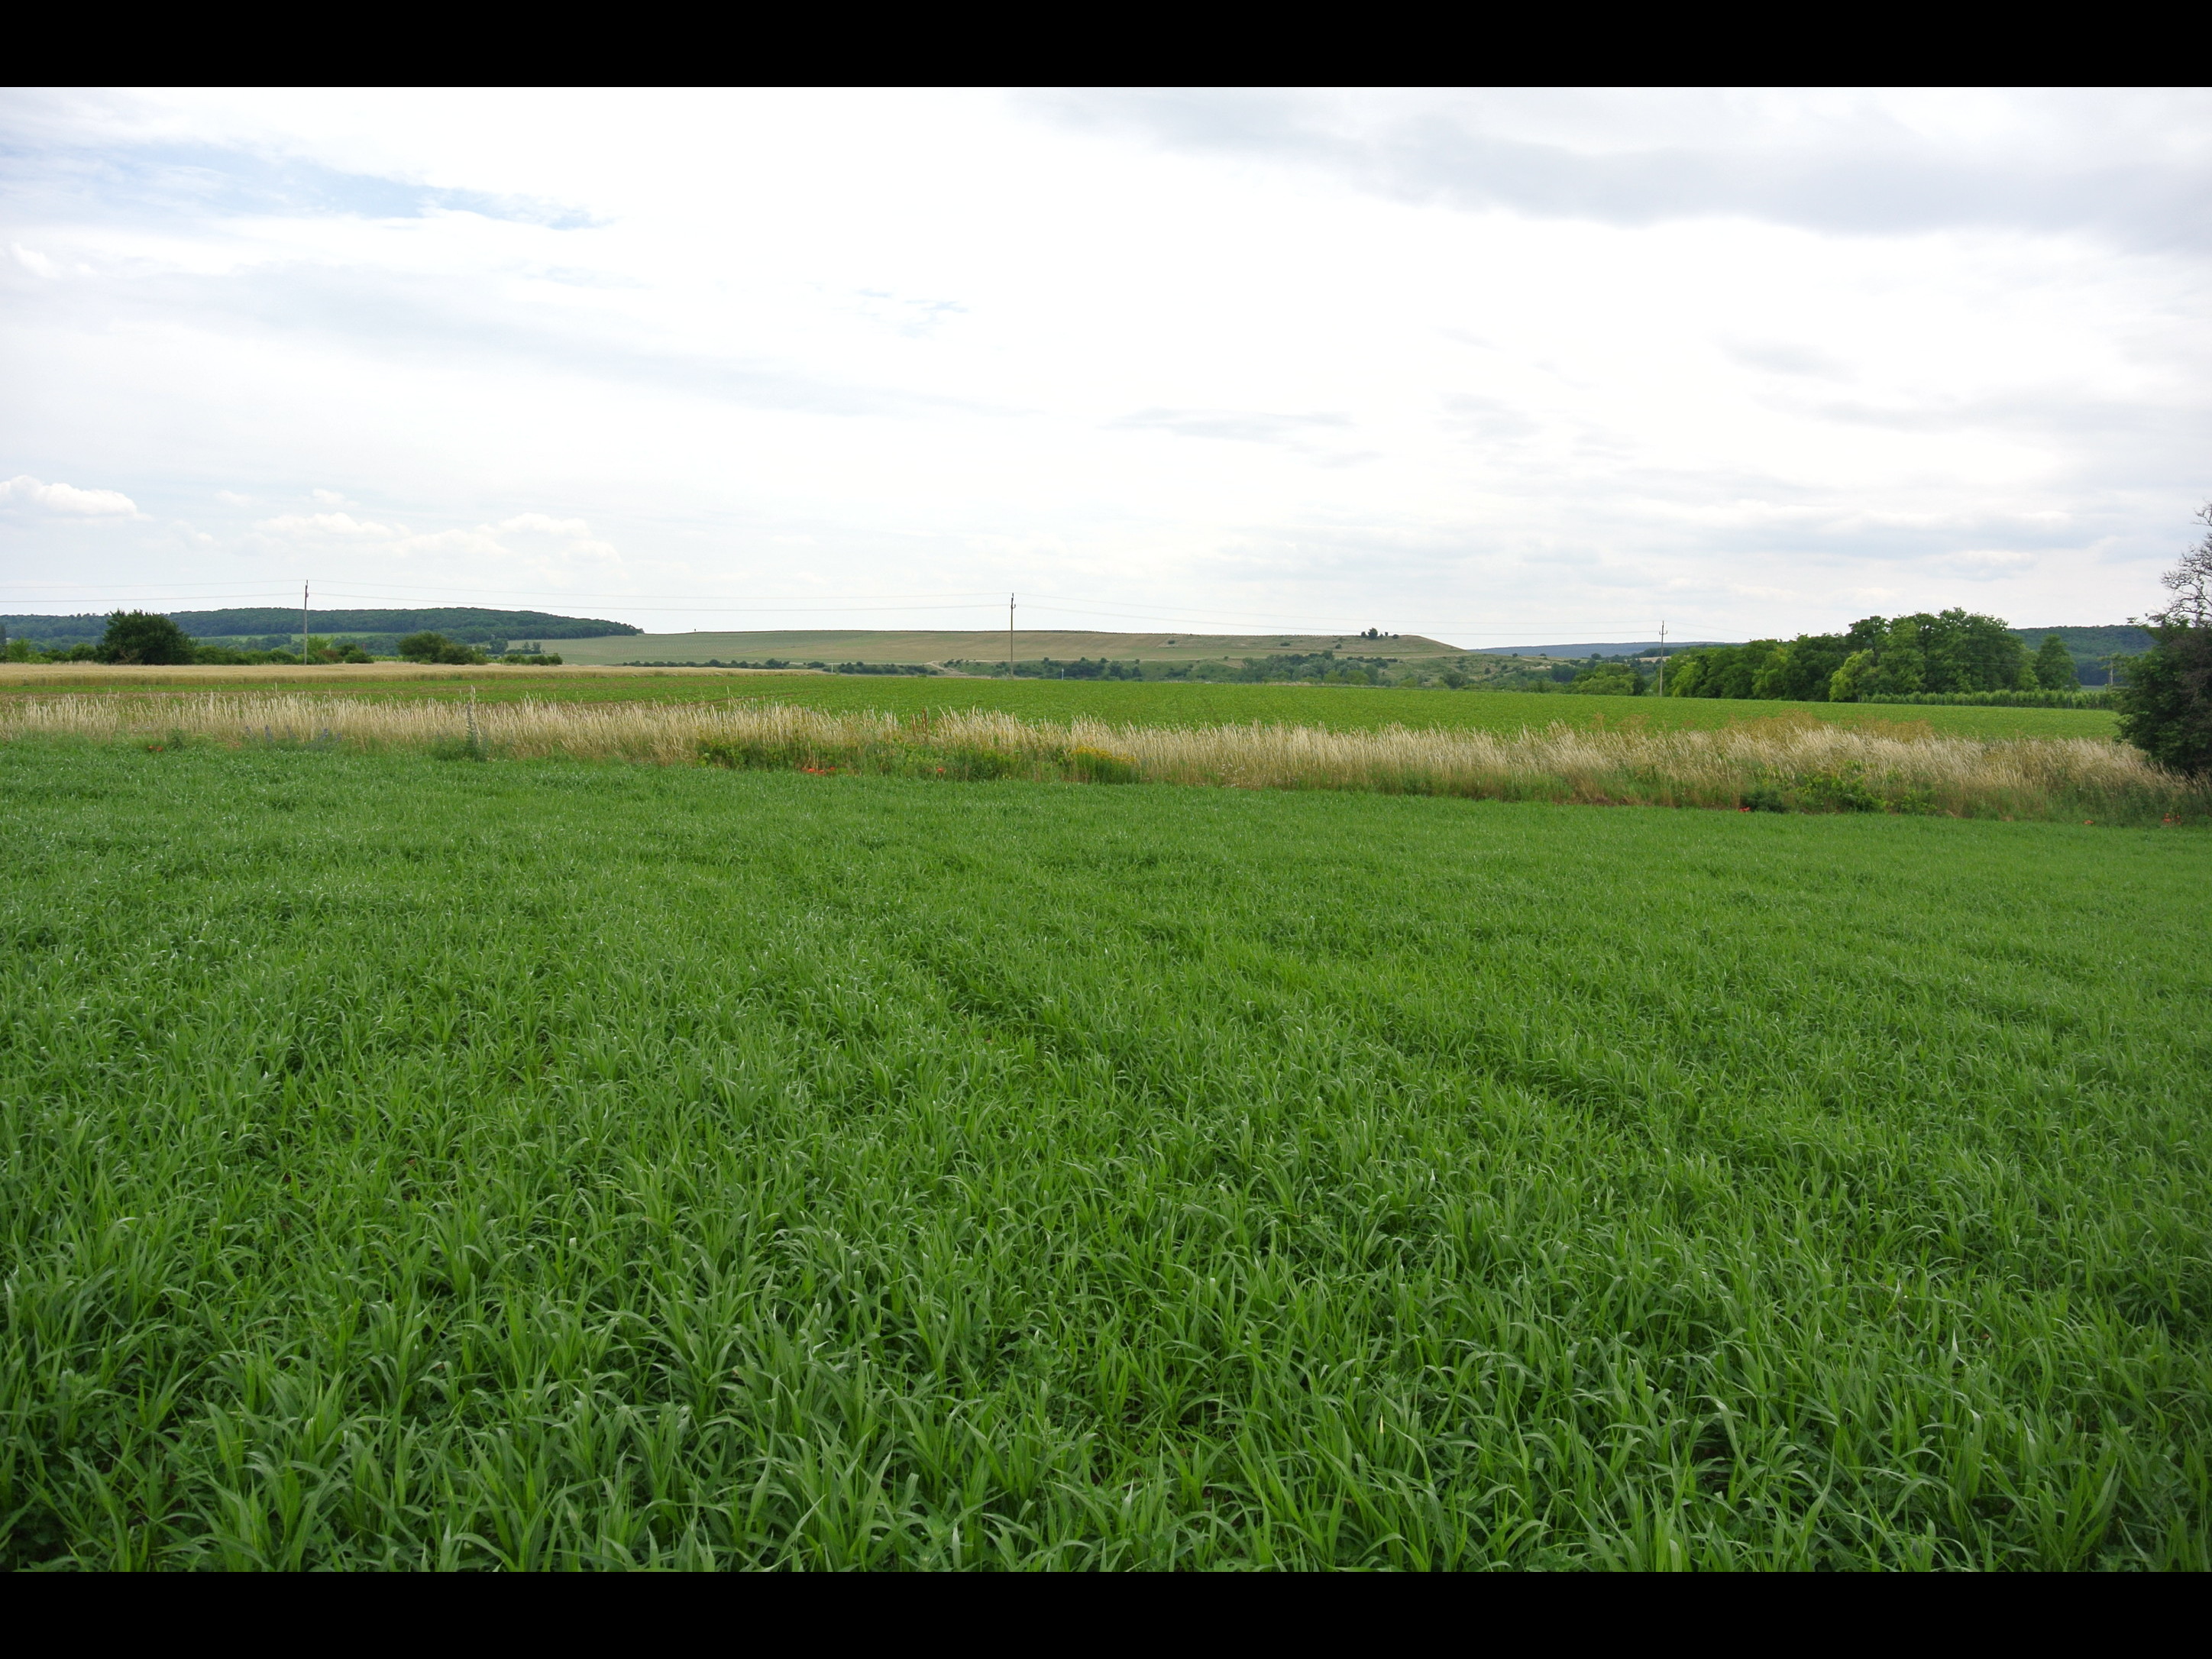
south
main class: Cropland
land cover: Common wheat
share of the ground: > 75 %
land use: Agriculture (excluding fallow land and kitchen gardens)
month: June
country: AT
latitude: 47.7918
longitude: 16.5860
